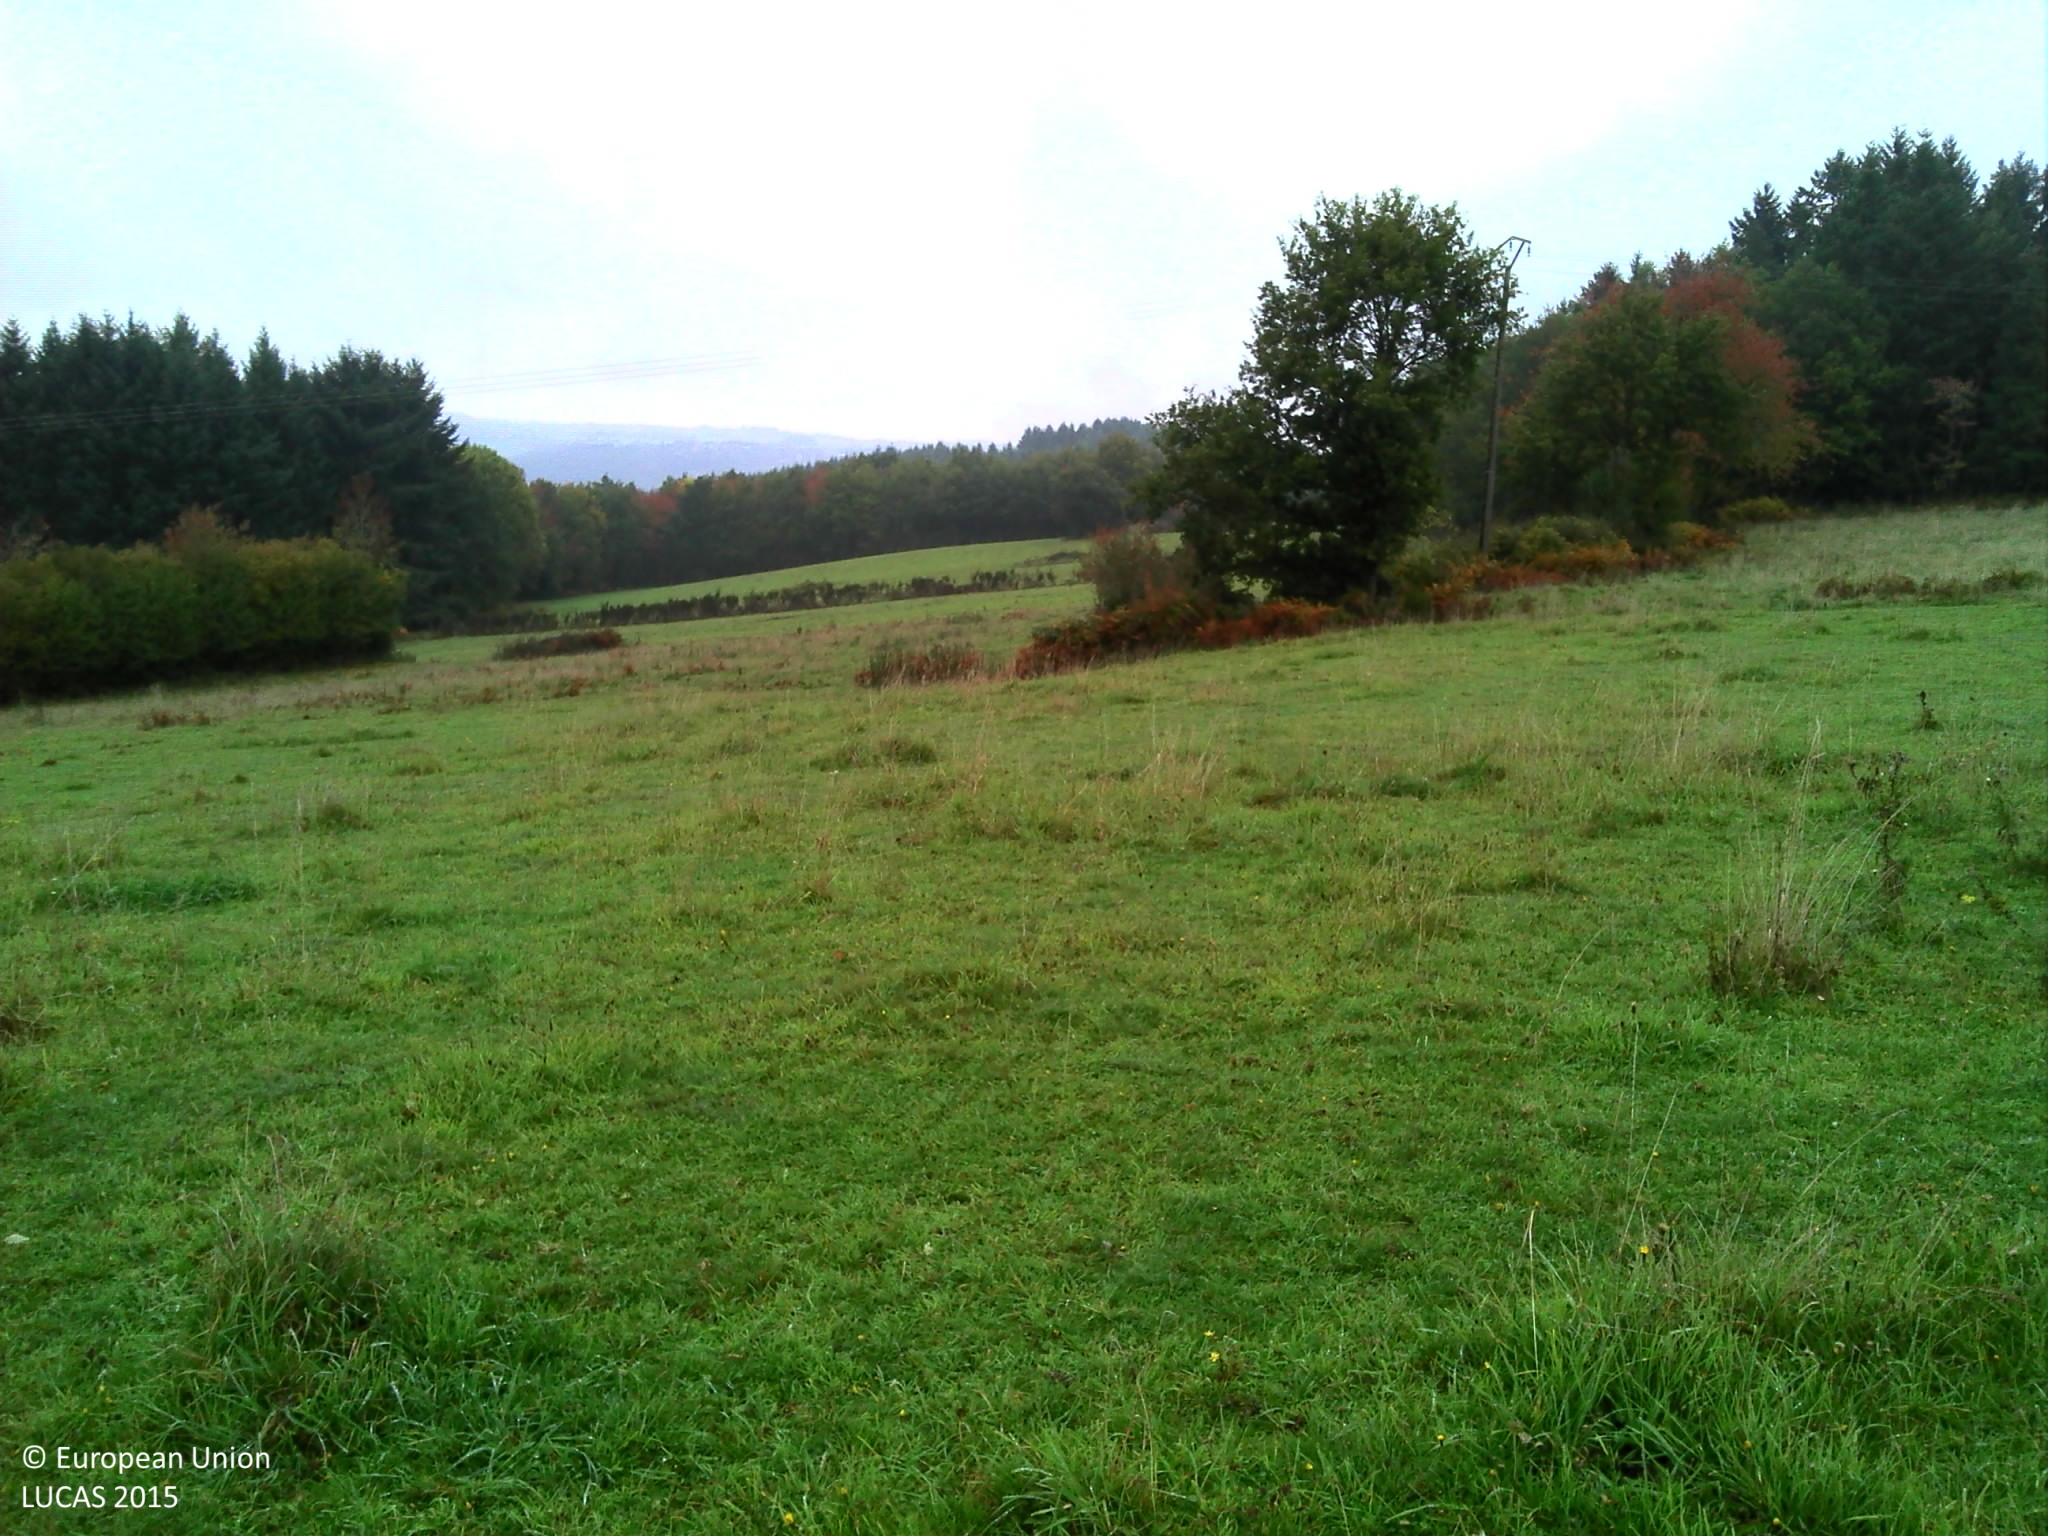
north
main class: Grassland
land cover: Grassland without tree/shrub cover
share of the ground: > 75 %
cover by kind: herbaceous plants 100 %
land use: Agriculture (excluding fallow land and kitchen gardens)
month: October
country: FR
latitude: 45.9662
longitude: 2.8361
